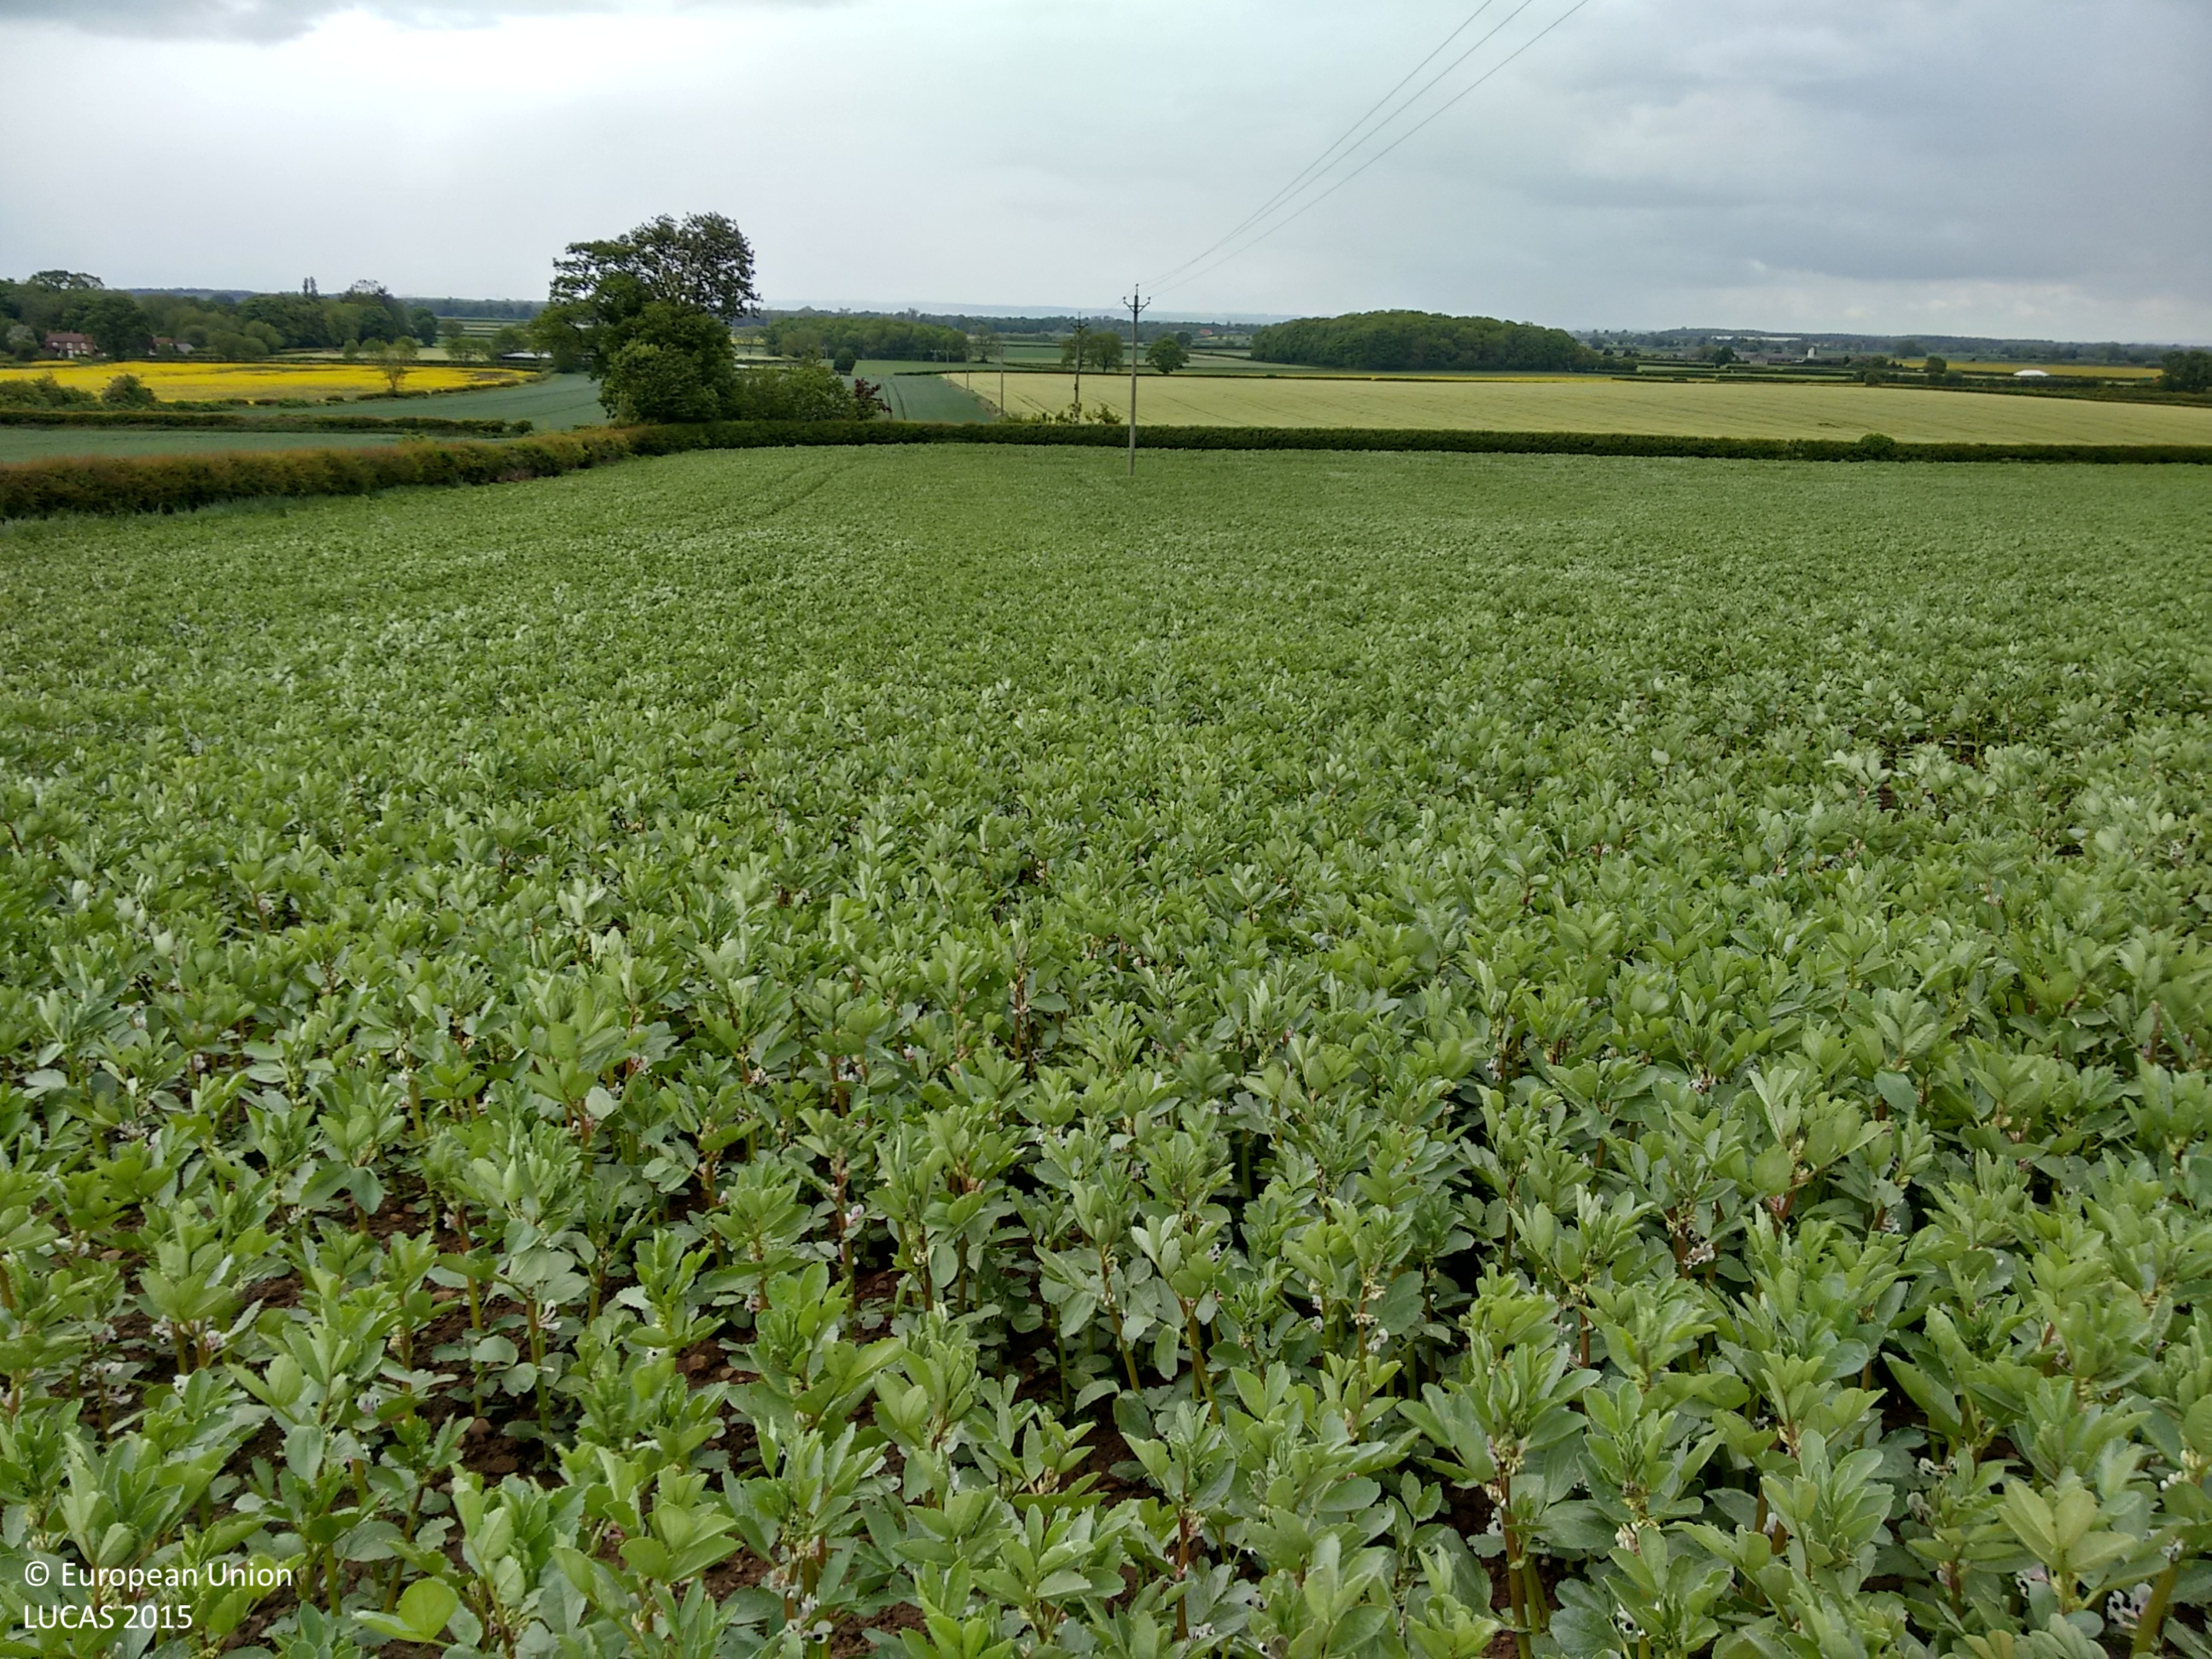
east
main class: Cropland
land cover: Dry pulses
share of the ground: > 75 %
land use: Agriculture (excluding fallow land and kitchen gardens)
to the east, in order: Dry pulses; Electric lines; Managed hedges; Grass margins; Paved roads, cycling and walking lanes; Grass margins; Electric lines; Managed hedges; Barley
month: June
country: GB
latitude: 54.0811
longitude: -1.3740
